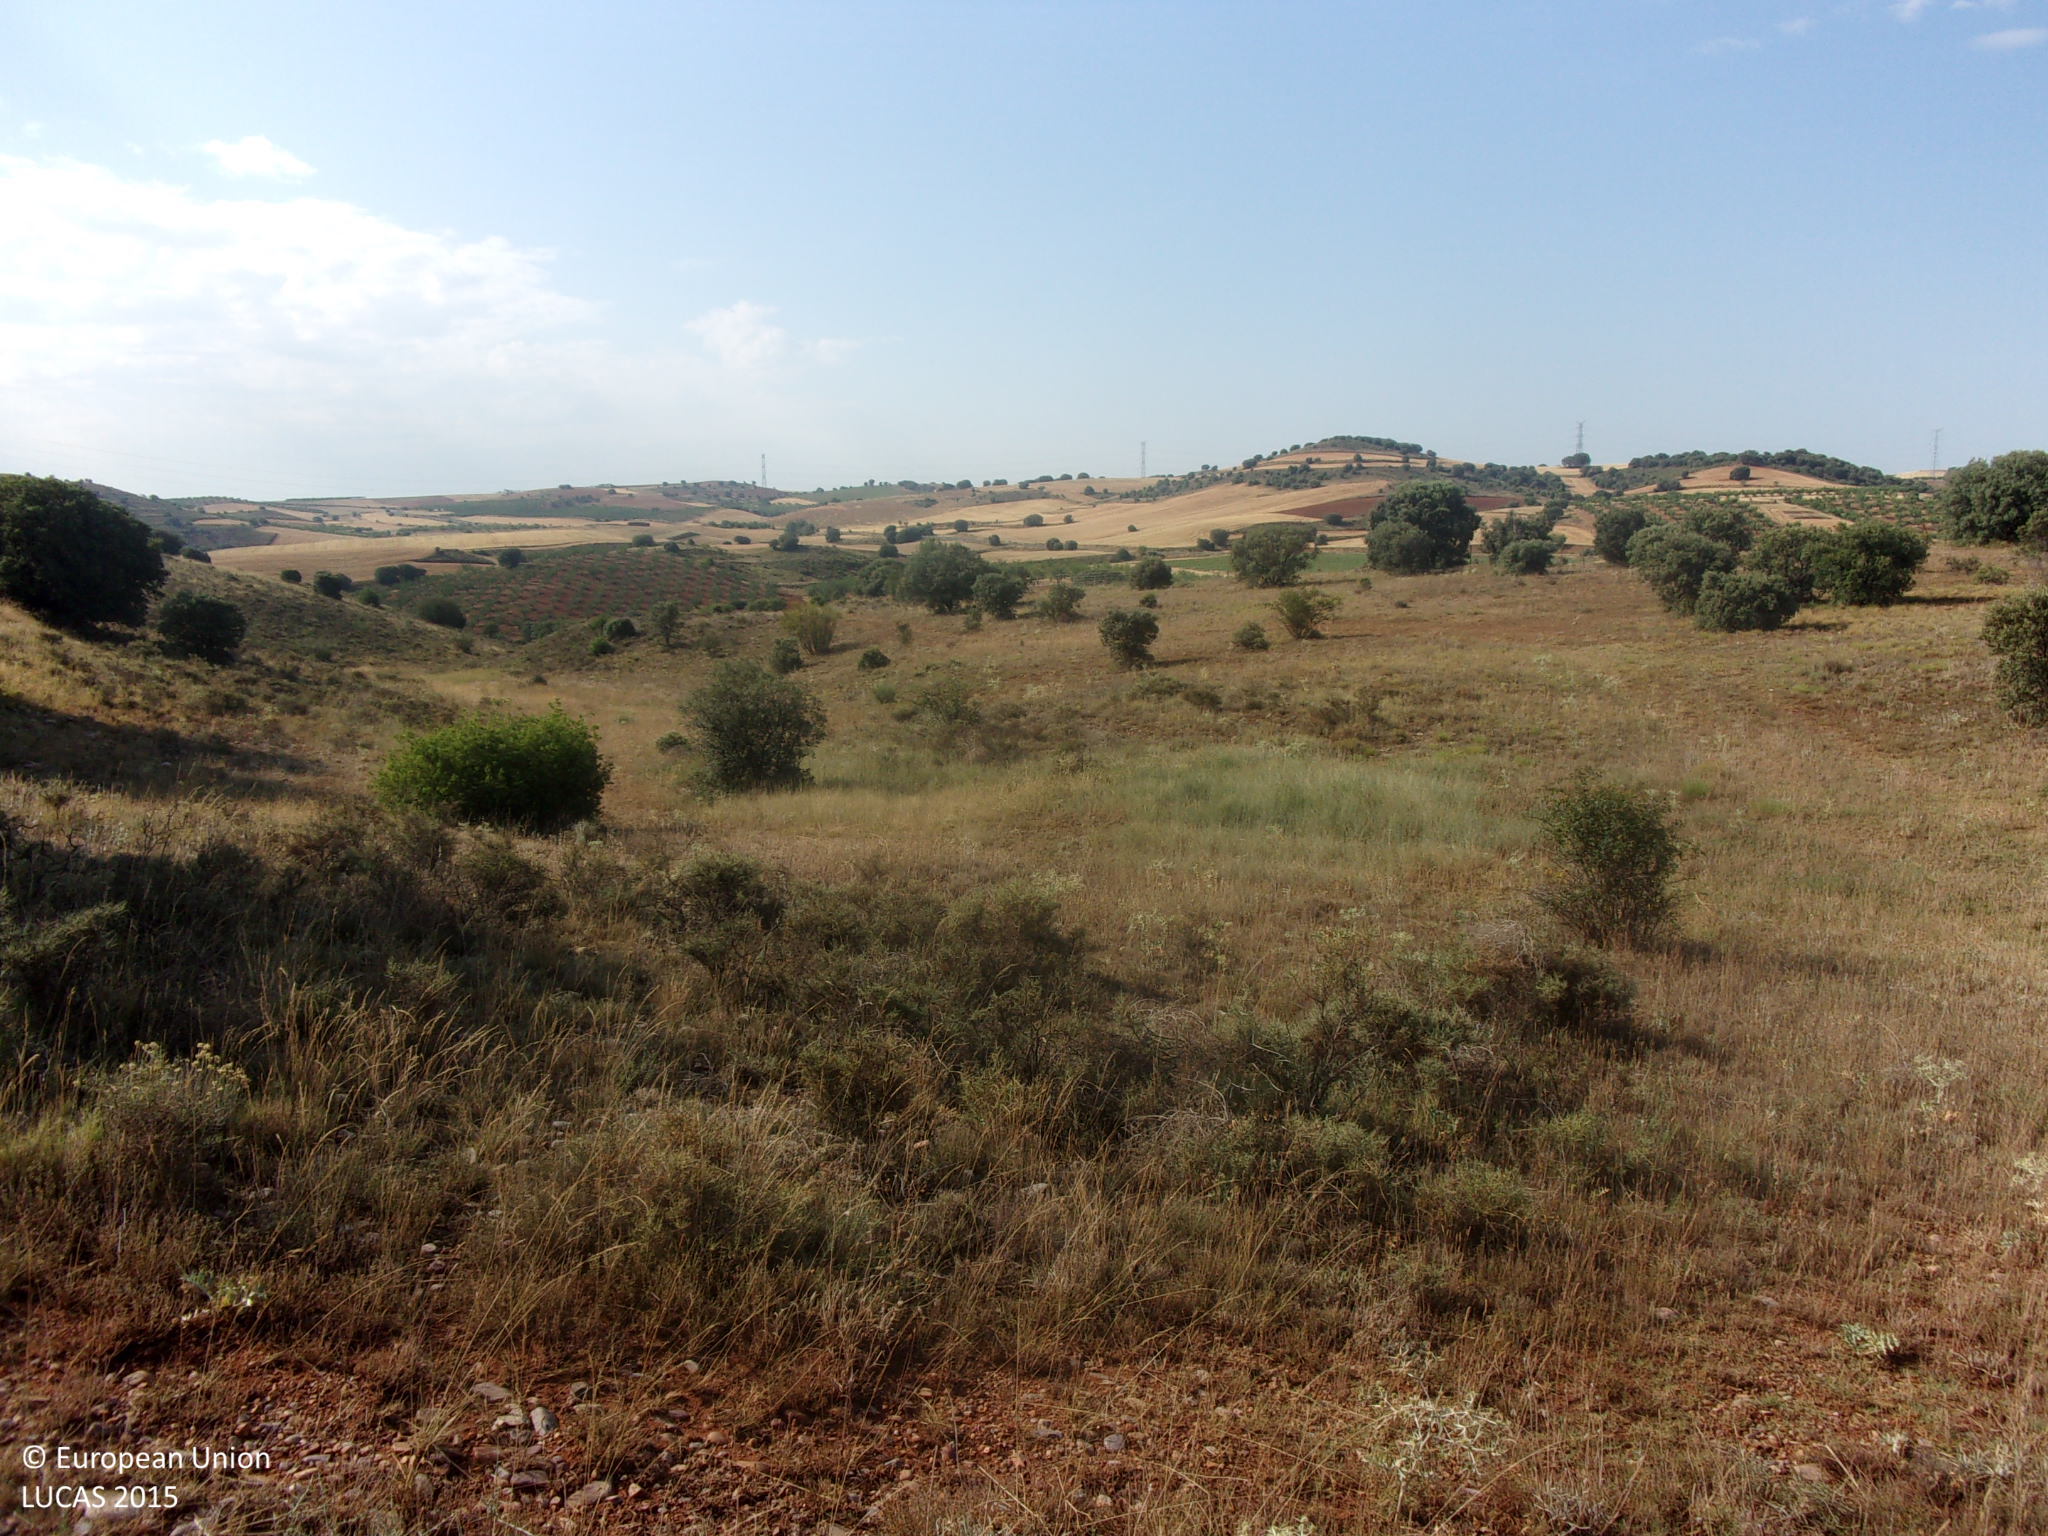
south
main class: Shrubland
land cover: Shrubland with sparse tree cover
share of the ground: > 75 %
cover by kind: shrubs 75 %, herbaceous plants 20 %, broadleaved forest trees 5 %
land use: Semi-natural and natural areas not in use
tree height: < 5 m
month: July
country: ES
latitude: 41.2358
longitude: -1.9220
